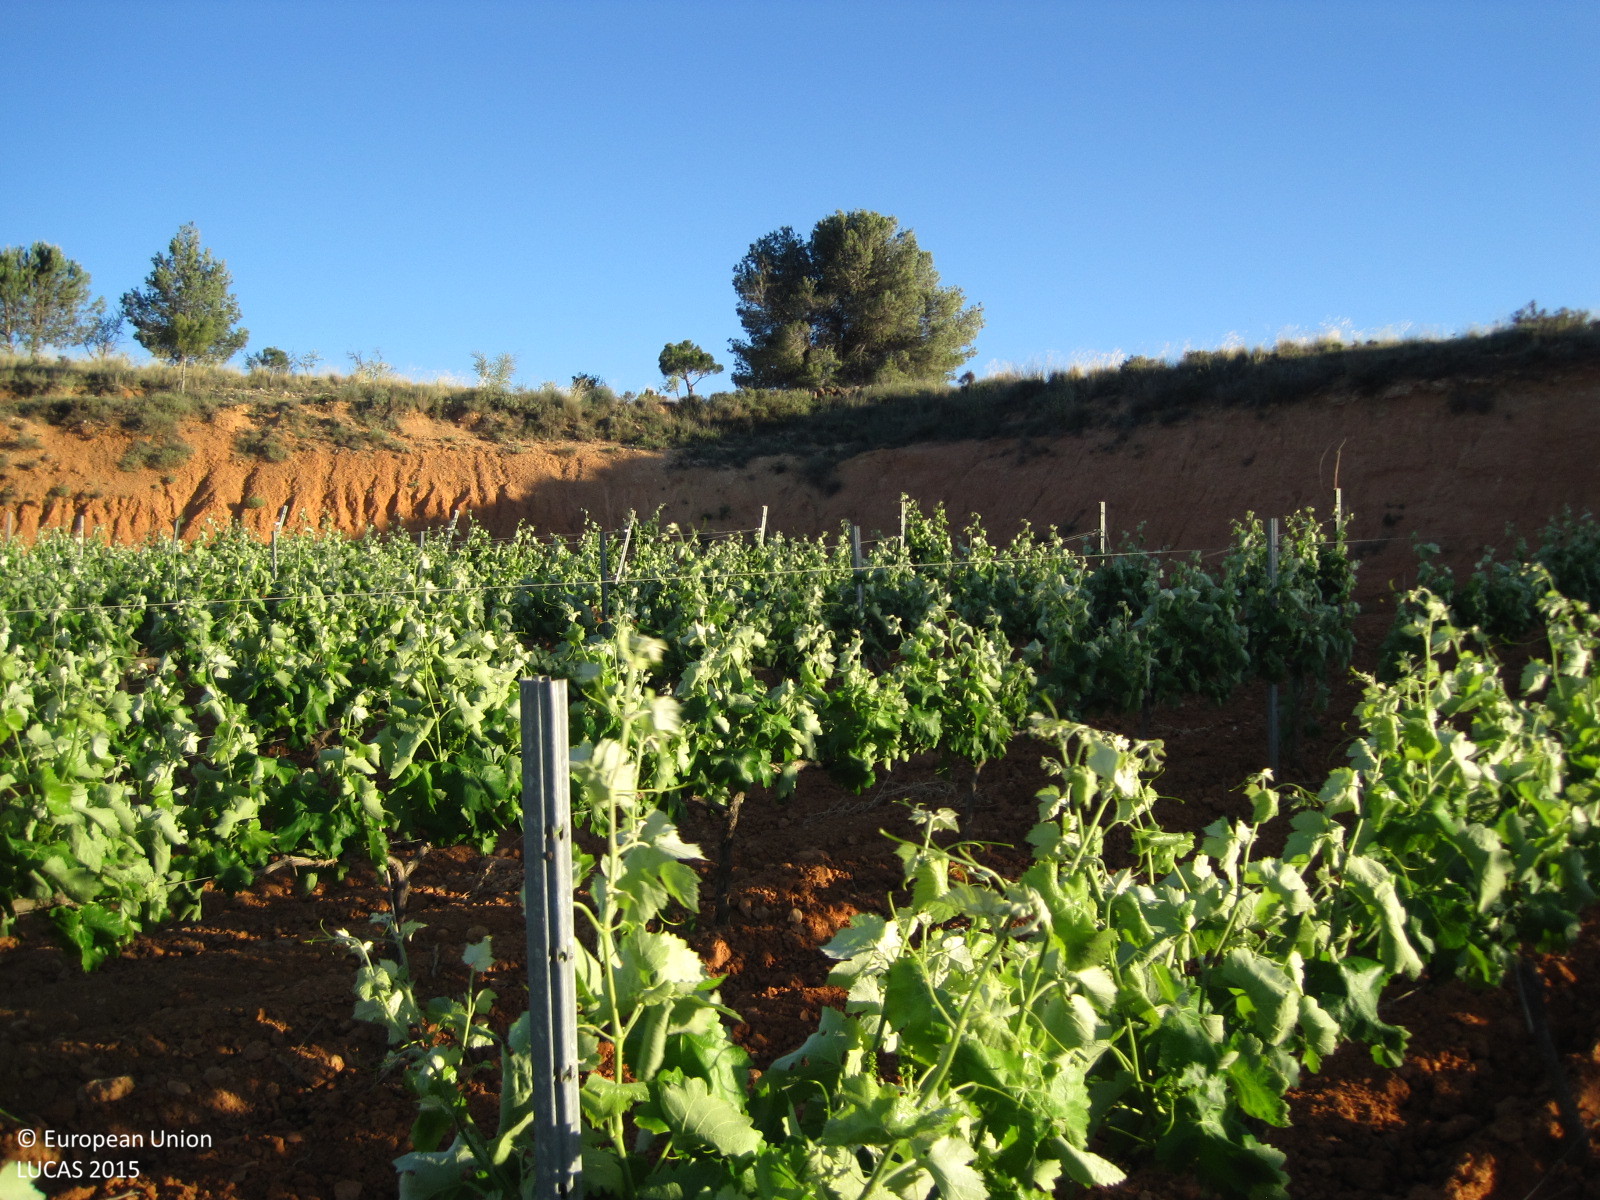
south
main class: Artificial land
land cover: Other artificial areas
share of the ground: > 75 %
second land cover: Vineyards
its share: 25 - 50 %
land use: Electricity, gas and thermal power distribution
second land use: Agriculture (excluding fallow land and kitchen gardens)
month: May
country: ES
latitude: 39.4709
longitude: -1.1021
